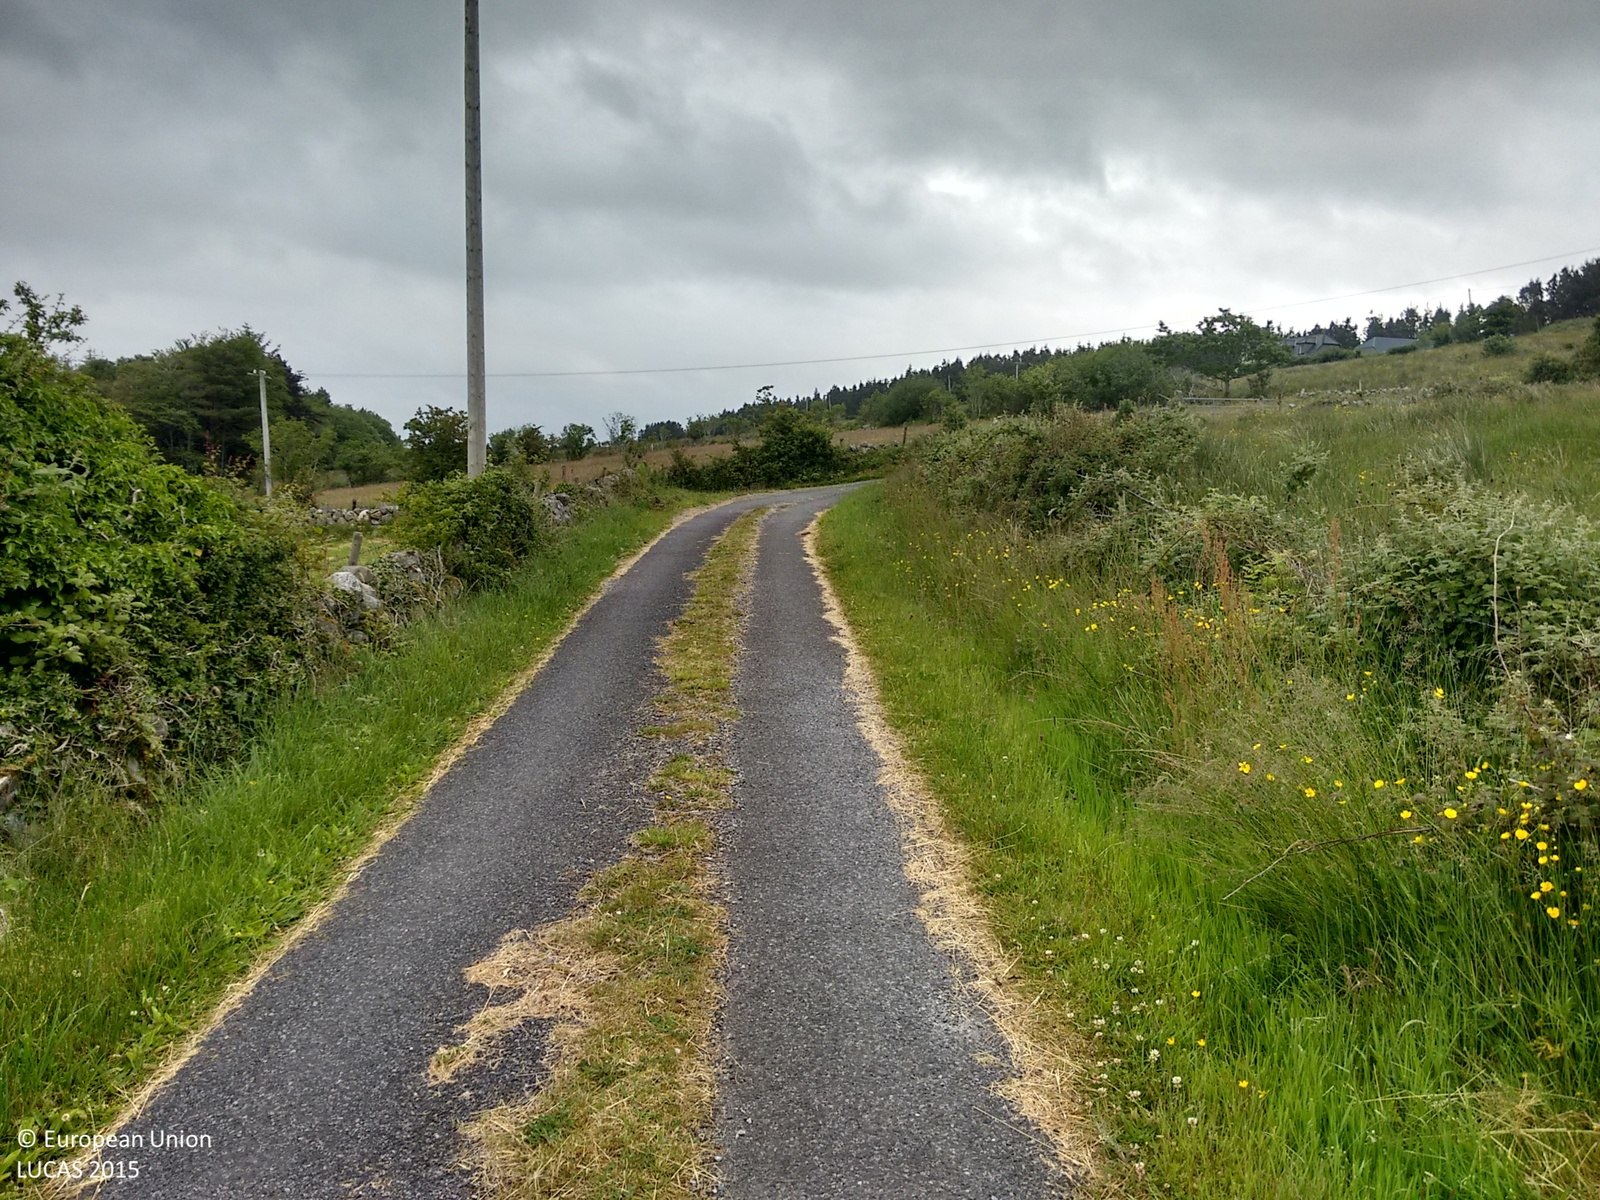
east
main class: Grassland
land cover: Grassland without tree/shrub cover
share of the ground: > 75 %
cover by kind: herbaceous plants 95 %, consolidated bare surface 5 %
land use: Agriculture (excluding fallow land and kitchen gardens)
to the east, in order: Paved roads, cycling and walking lanes; Electric lines; Grass margins; Dry stone walls; Fences; Grass margins; Dry stone walls; Fences; Grass margins; Paved roads, cycling and walking lanes; Grass margins; Dry stone walls; Electric lines; Grassland without tree/shrub cover; Abandoned hedges; Dry stone walls; Fences; Ditches and canals; Grassland without tree/shrub cover; Ditches and canals; Grassland without tree/shrub cover
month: June
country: IE
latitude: 53.1220
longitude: -8.4985
